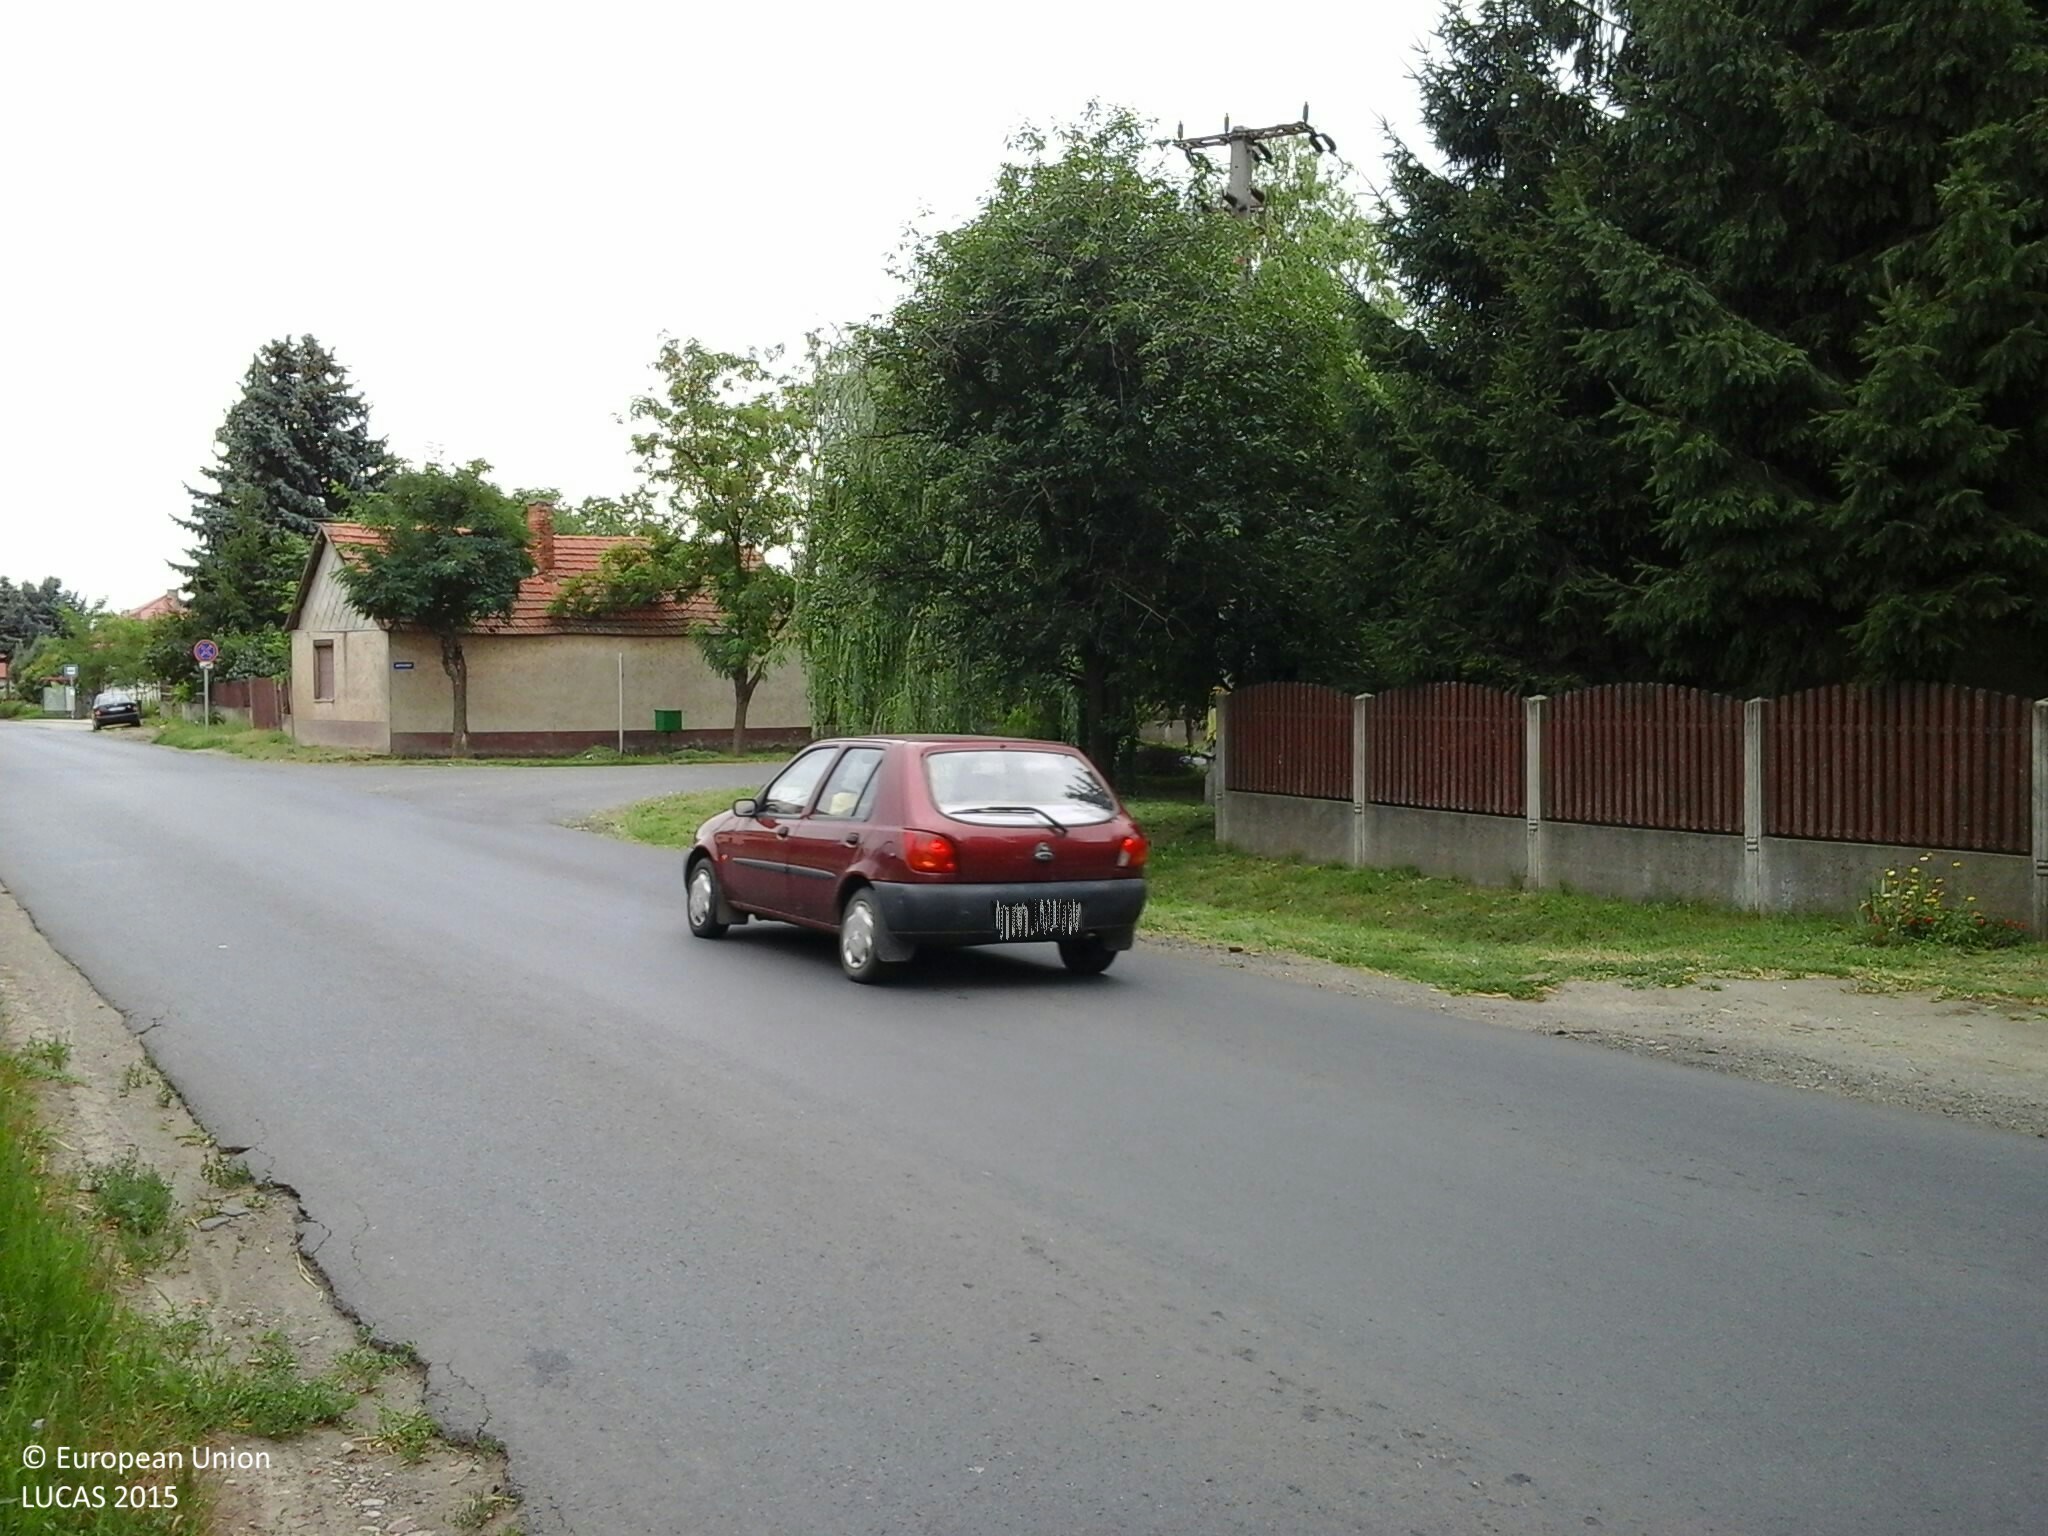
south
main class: Grassland
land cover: Grassland without tree/shrub cover
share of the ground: > 75 %
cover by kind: herbaceous plants 100 %
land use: Residential
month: July
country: HU
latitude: 47.8204
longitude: 21.4907
